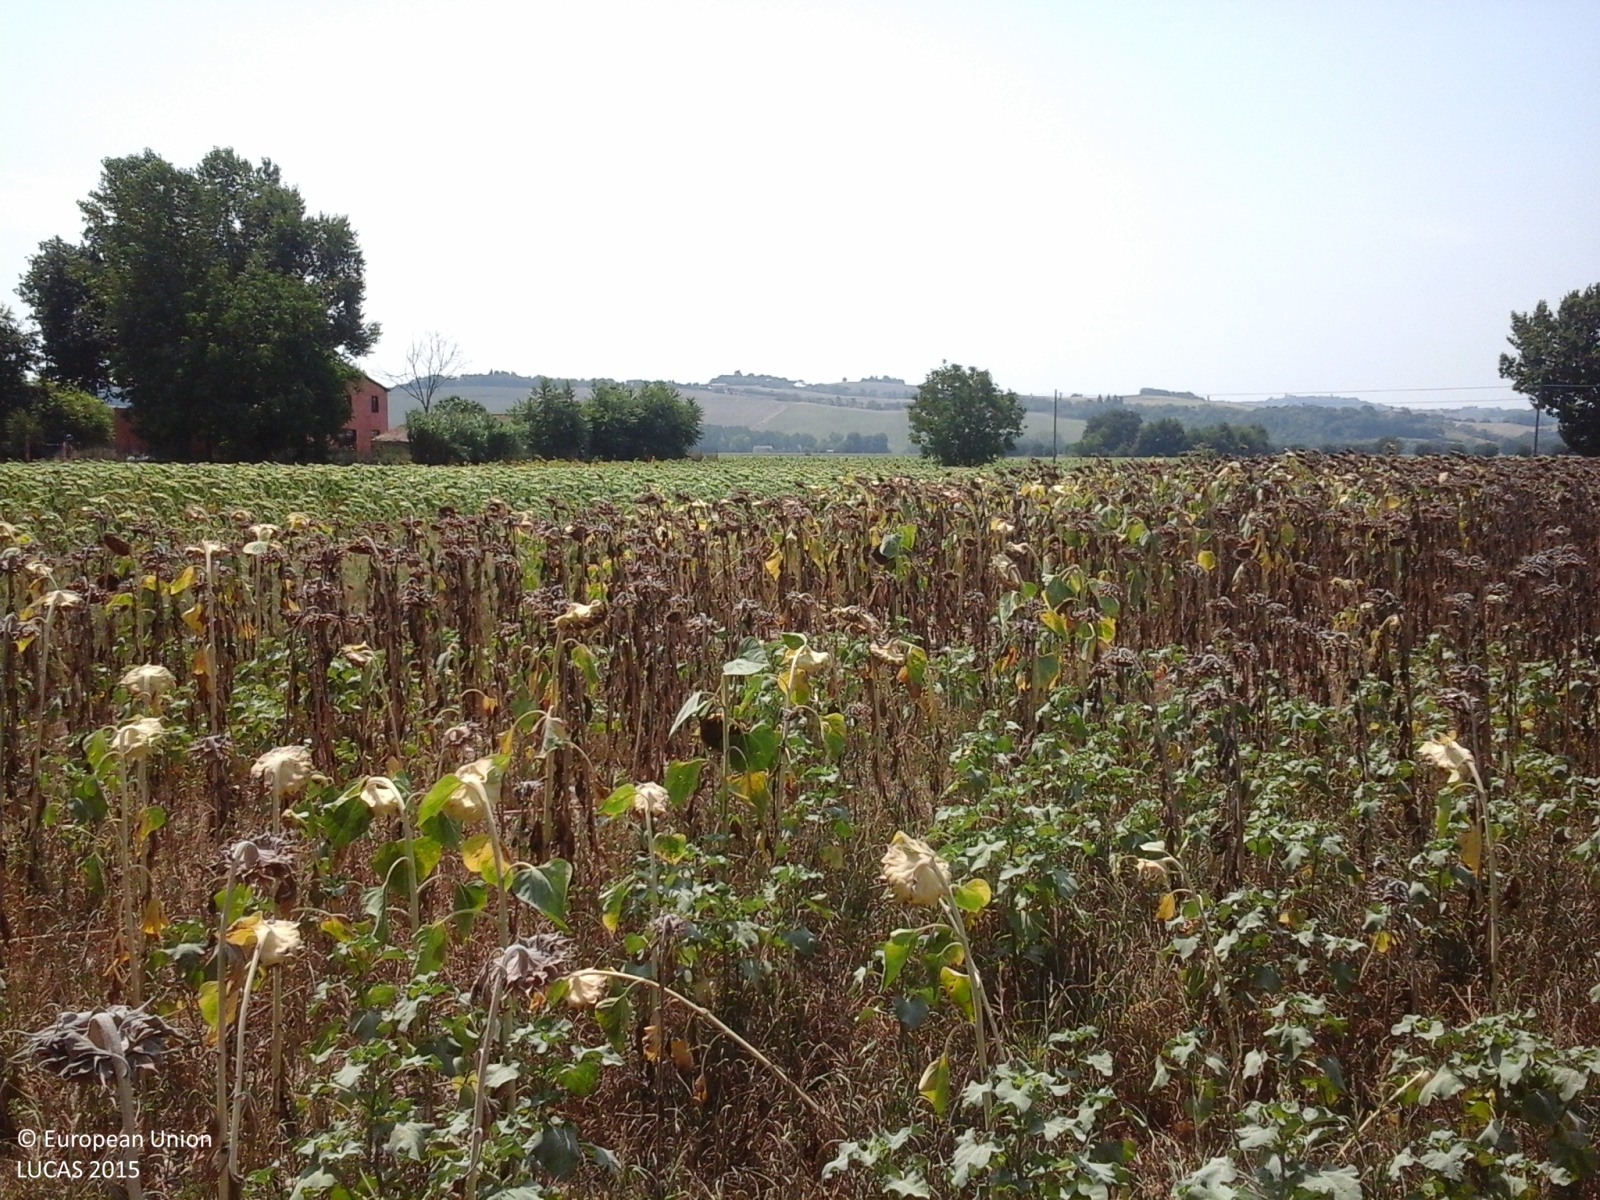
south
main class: Cropland
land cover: Sunflower
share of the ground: > 75 %
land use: Agriculture (excluding fallow land and kitchen gardens)
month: August
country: IT
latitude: 43.4621
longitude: 13.4646
